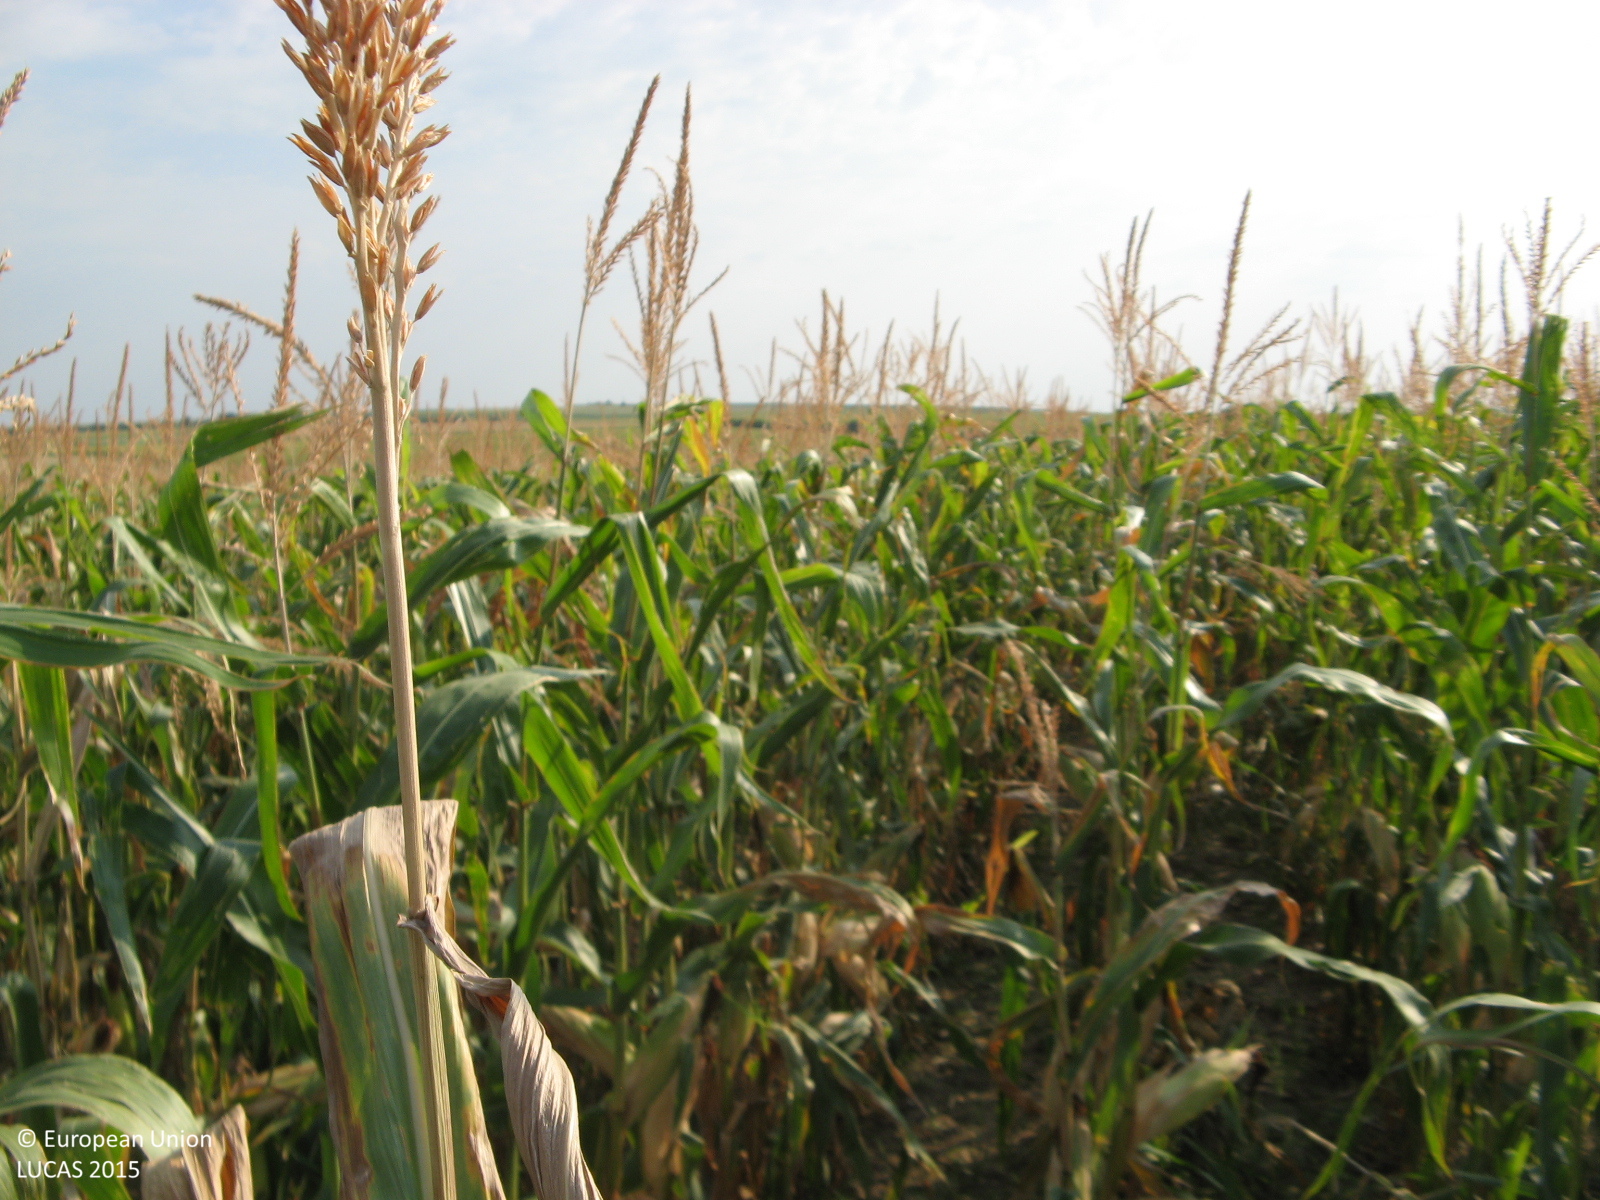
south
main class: Cropland
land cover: Maize
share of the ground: > 75 %
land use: Agriculture (excluding fallow land and kitchen gardens)
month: August
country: BG
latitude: 43.5611
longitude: 25.2675
